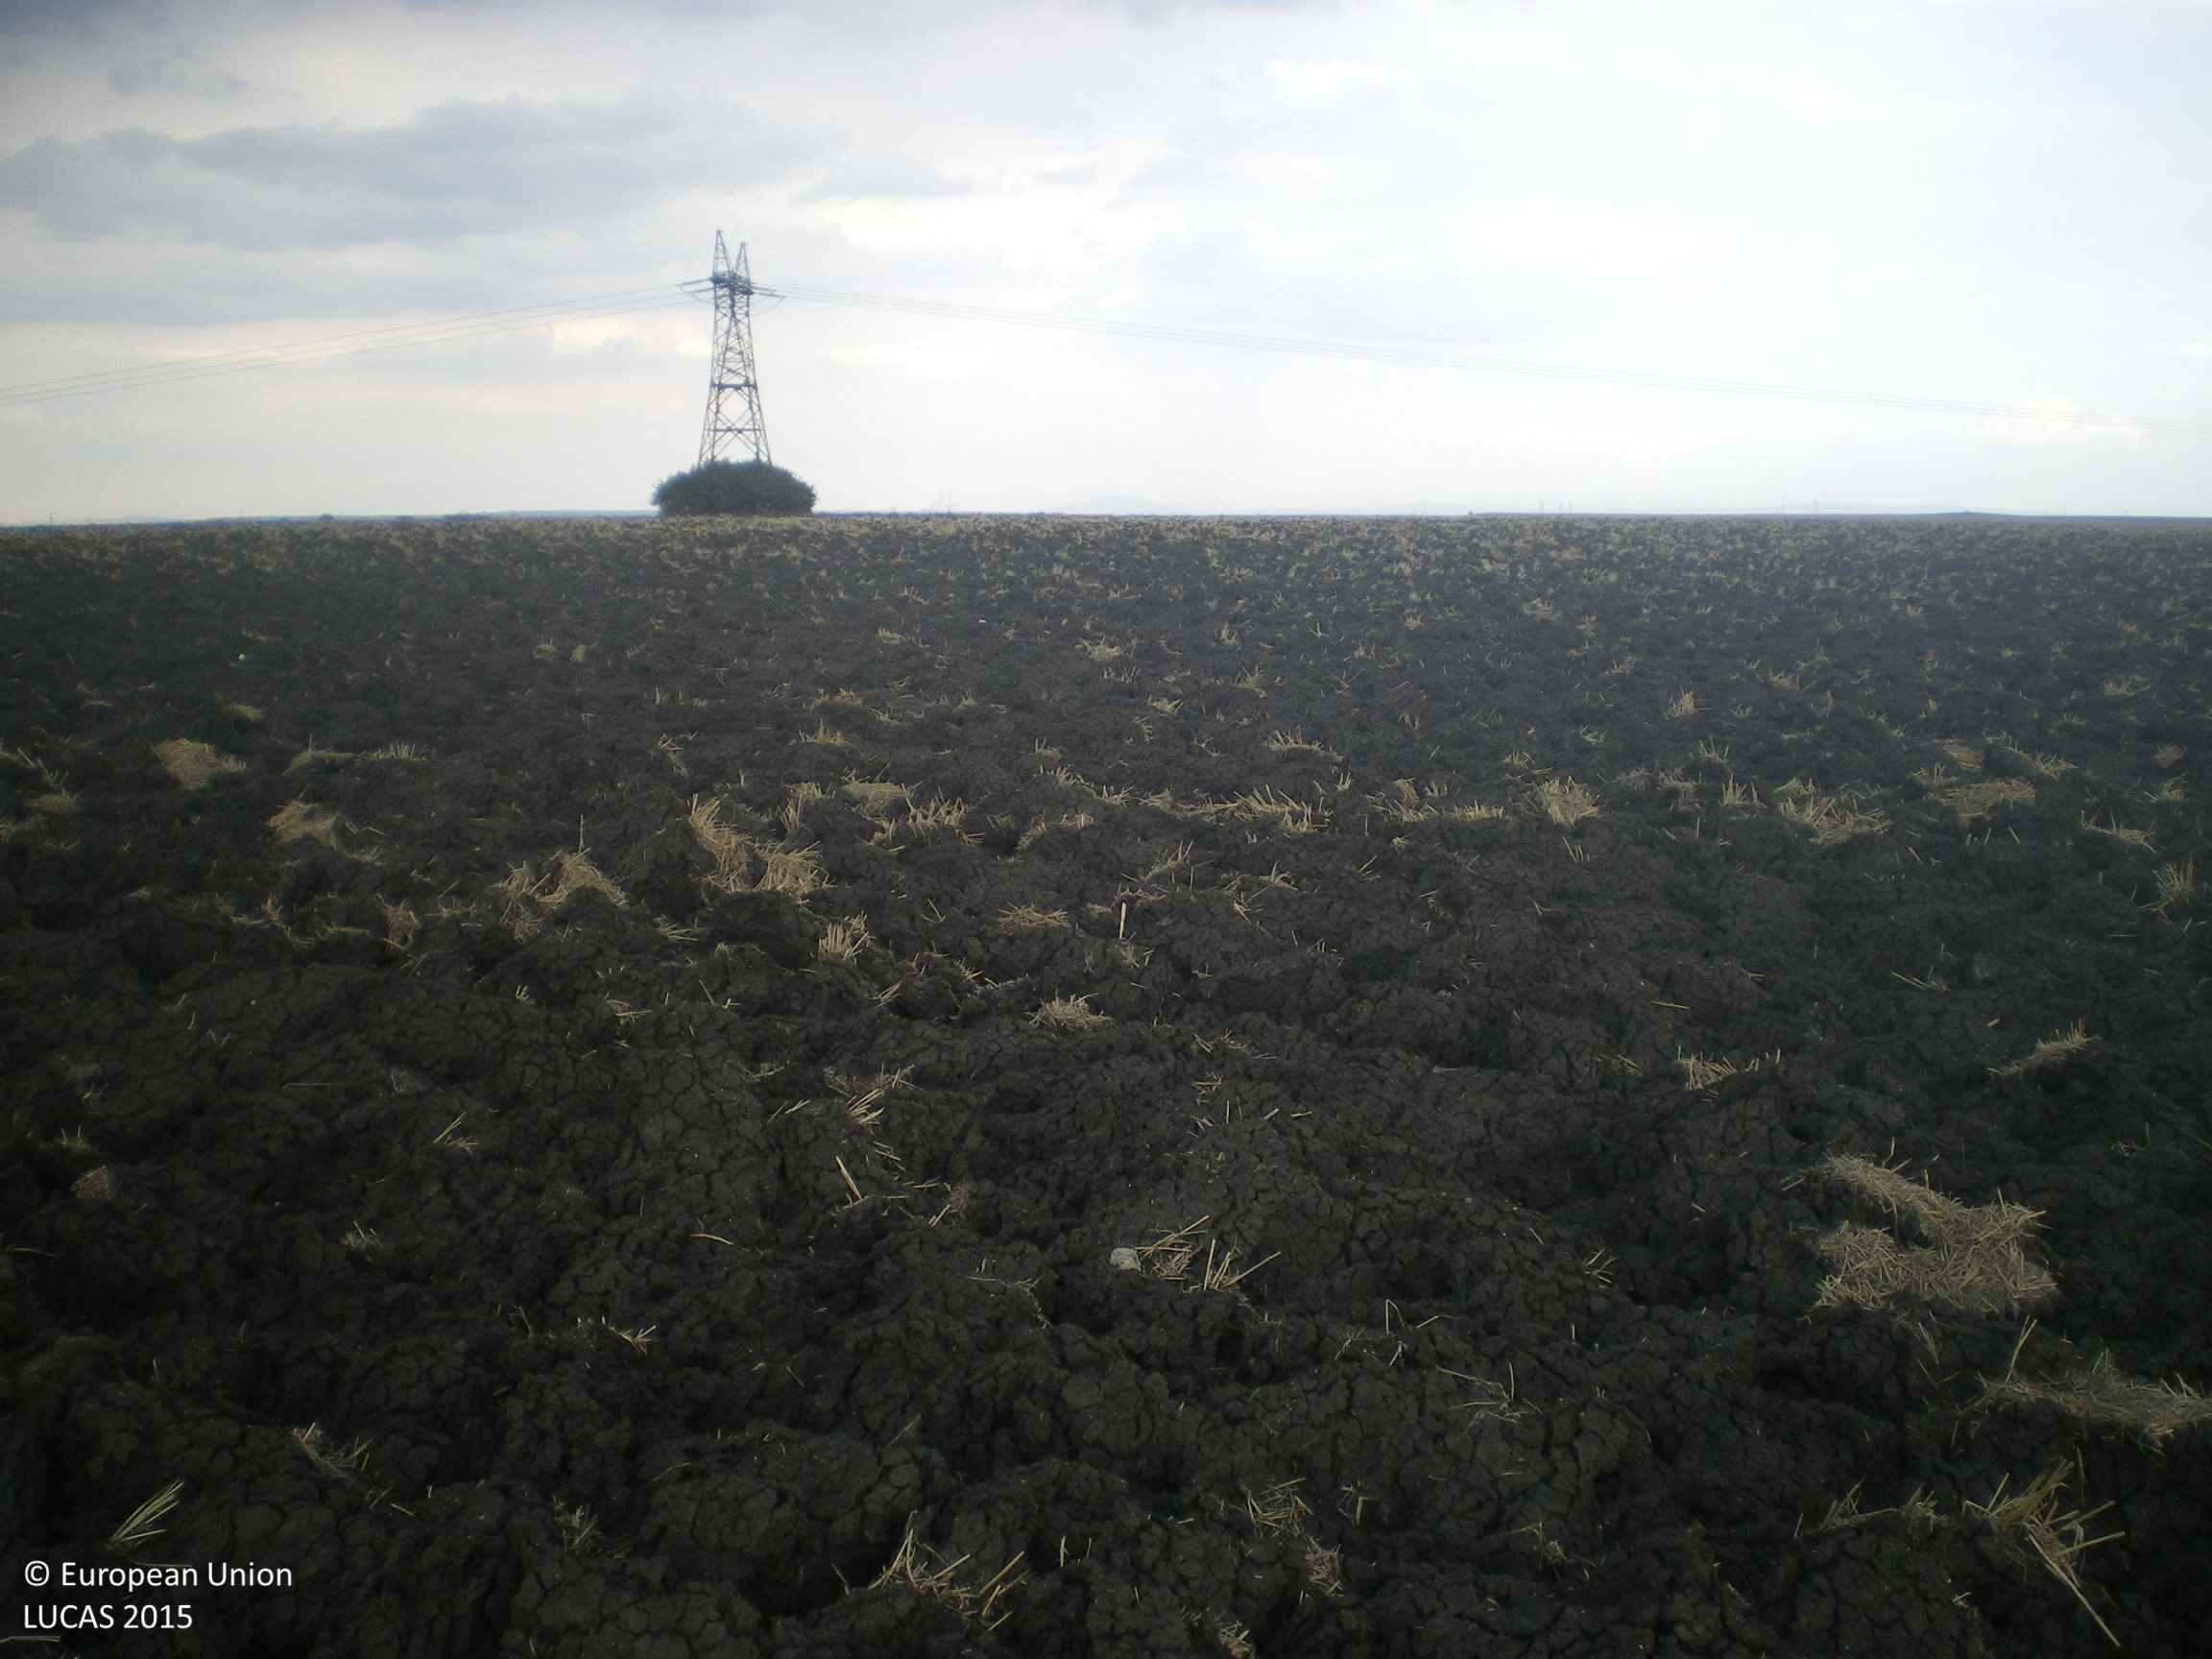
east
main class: Cropland
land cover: Oats
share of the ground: < 10 %
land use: Agriculture (excluding fallow land and kitchen gardens)
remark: Harvested field
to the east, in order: Oats; Tracks
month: August
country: BG
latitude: 42.2607
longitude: 25.8457
